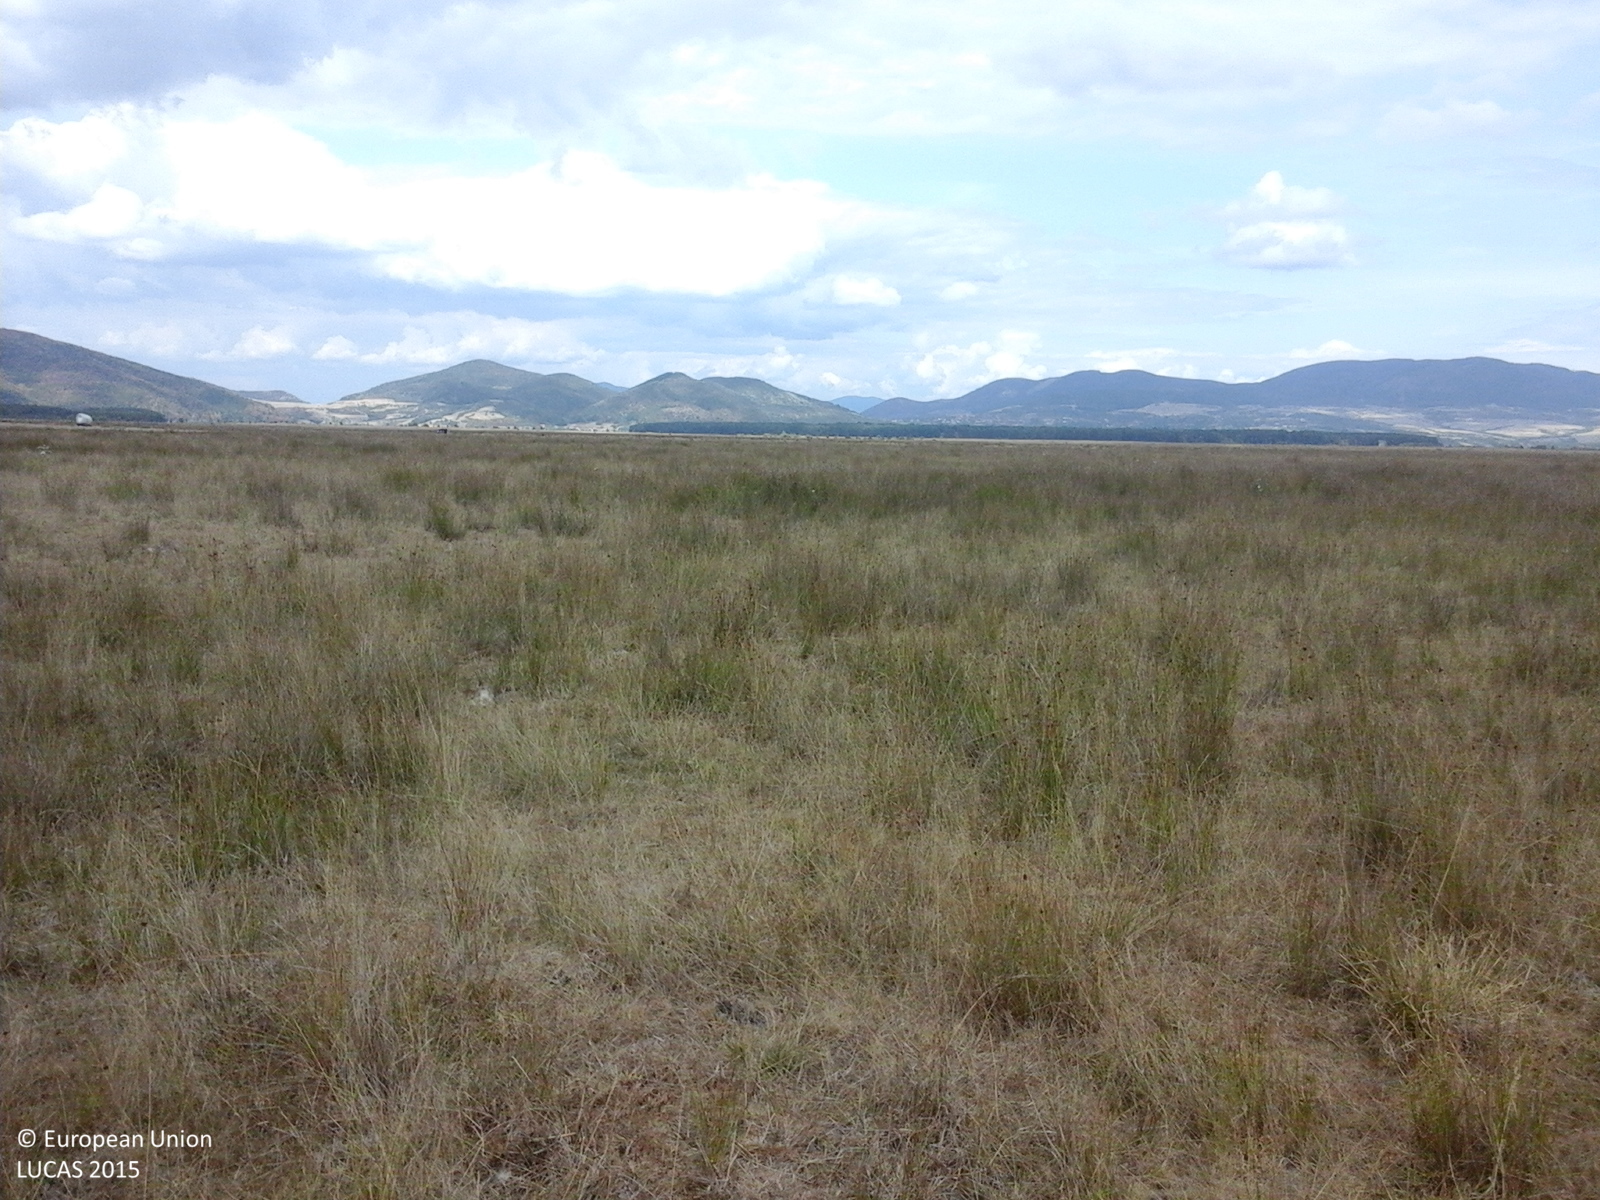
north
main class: Grassland
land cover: Grassland without tree/shrub cover
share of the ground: > 75 %
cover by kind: herbaceous plants 100 %
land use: Agriculture (excluding fallow land and kitchen gardens)
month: September
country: RO
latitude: 47.8827
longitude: 23.1887
